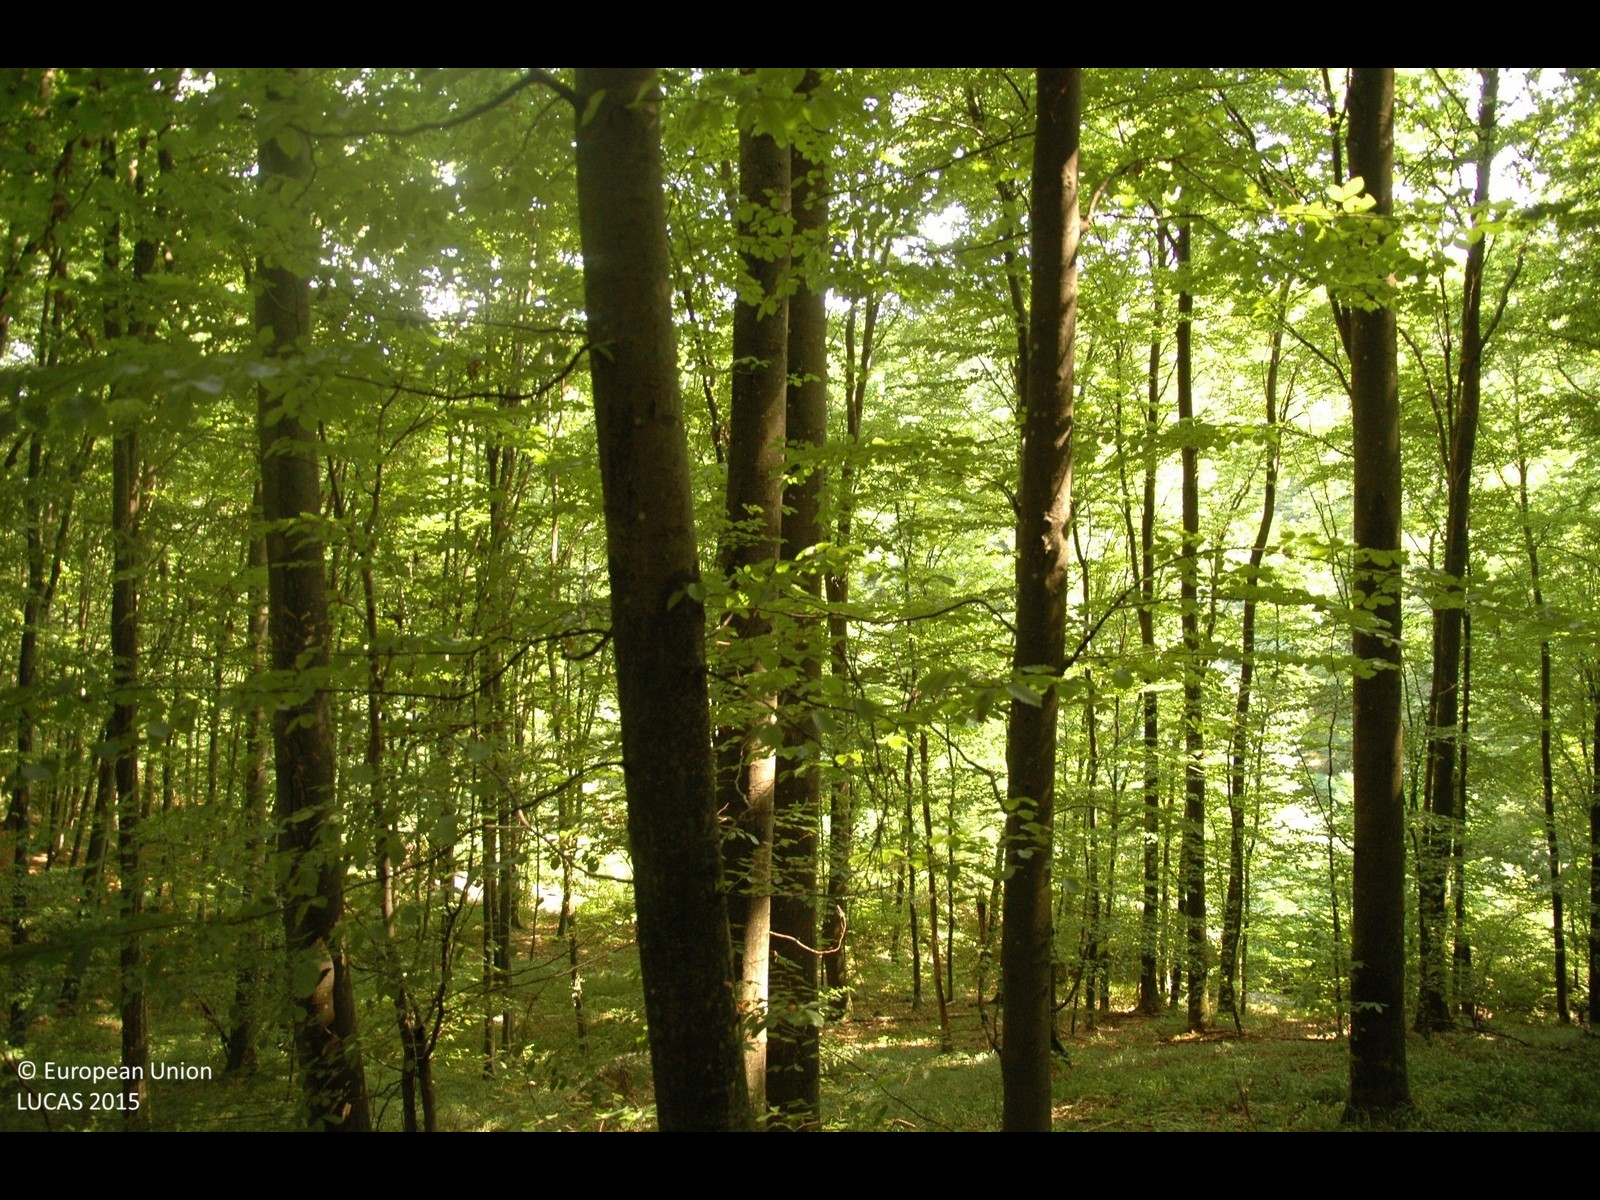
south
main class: Woodland
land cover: Broadleaved woodland
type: beech forest
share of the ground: > 75 %
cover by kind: broadleaved forest trees 100 %
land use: Forestry
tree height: > 5 m
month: July
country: HR
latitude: 46.1511
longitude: 16.5389
